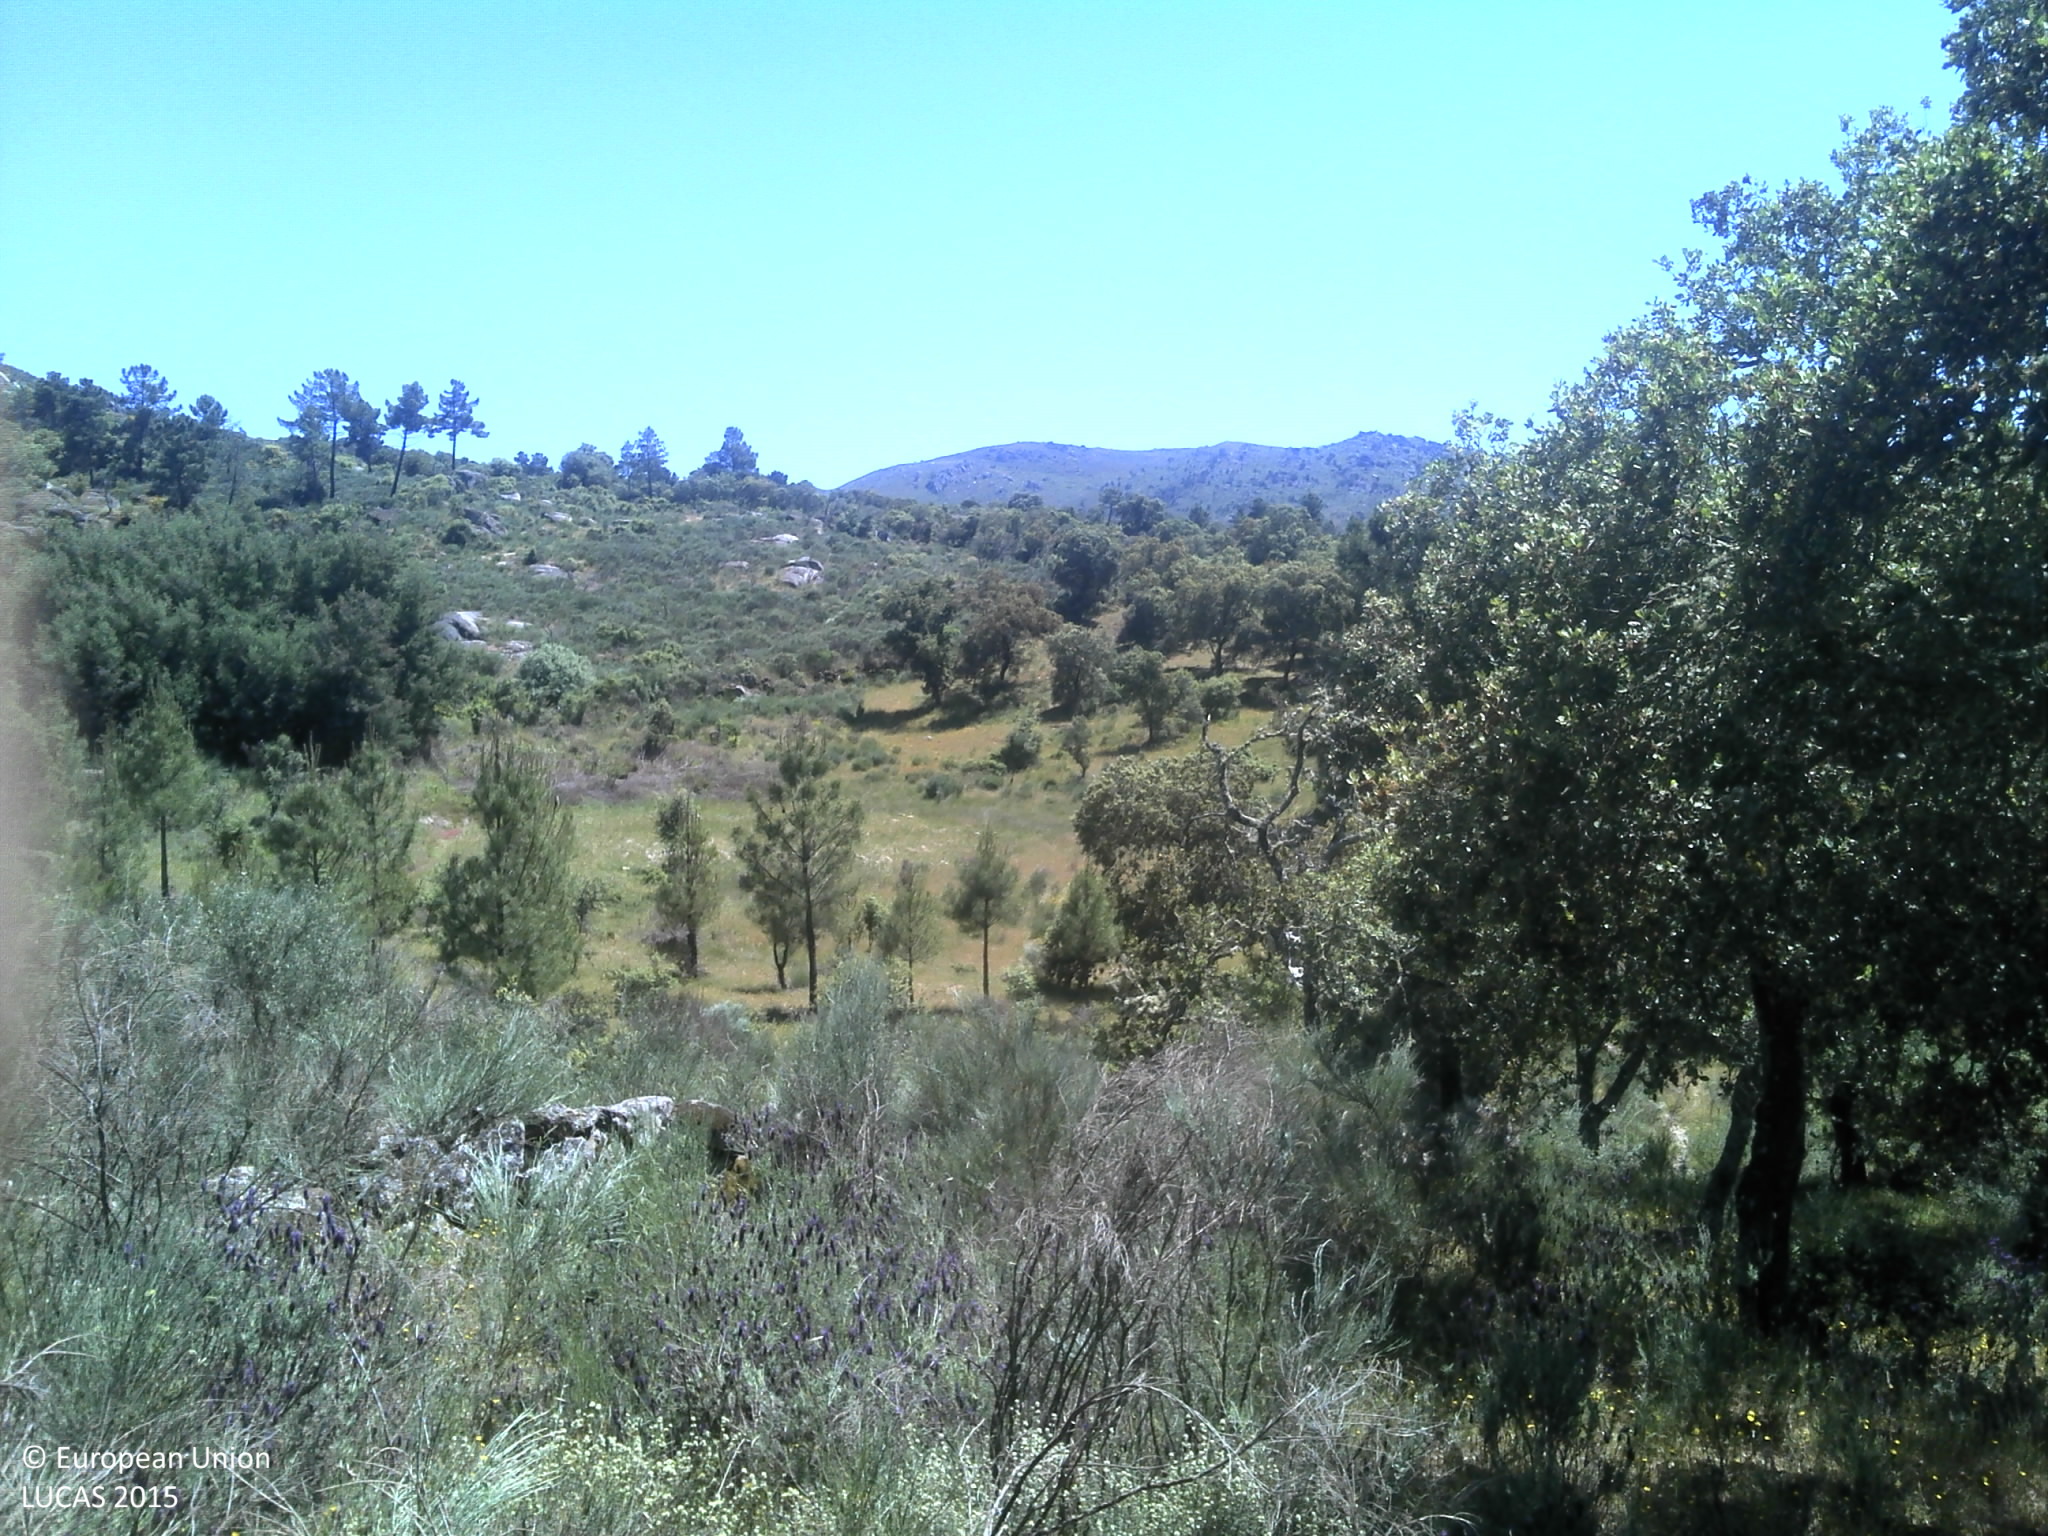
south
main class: Shrubland
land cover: Shrubland with sparse tree cover
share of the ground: 50 - 75 %
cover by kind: shrubs 60 %, herbaceous plants 20 %, unconsolidated bare surface 10 %, broadleaved forest trees 5 %
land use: Abandoned areas
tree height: > 5 m
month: May
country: PT
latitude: 40.6379
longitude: -7.2883
